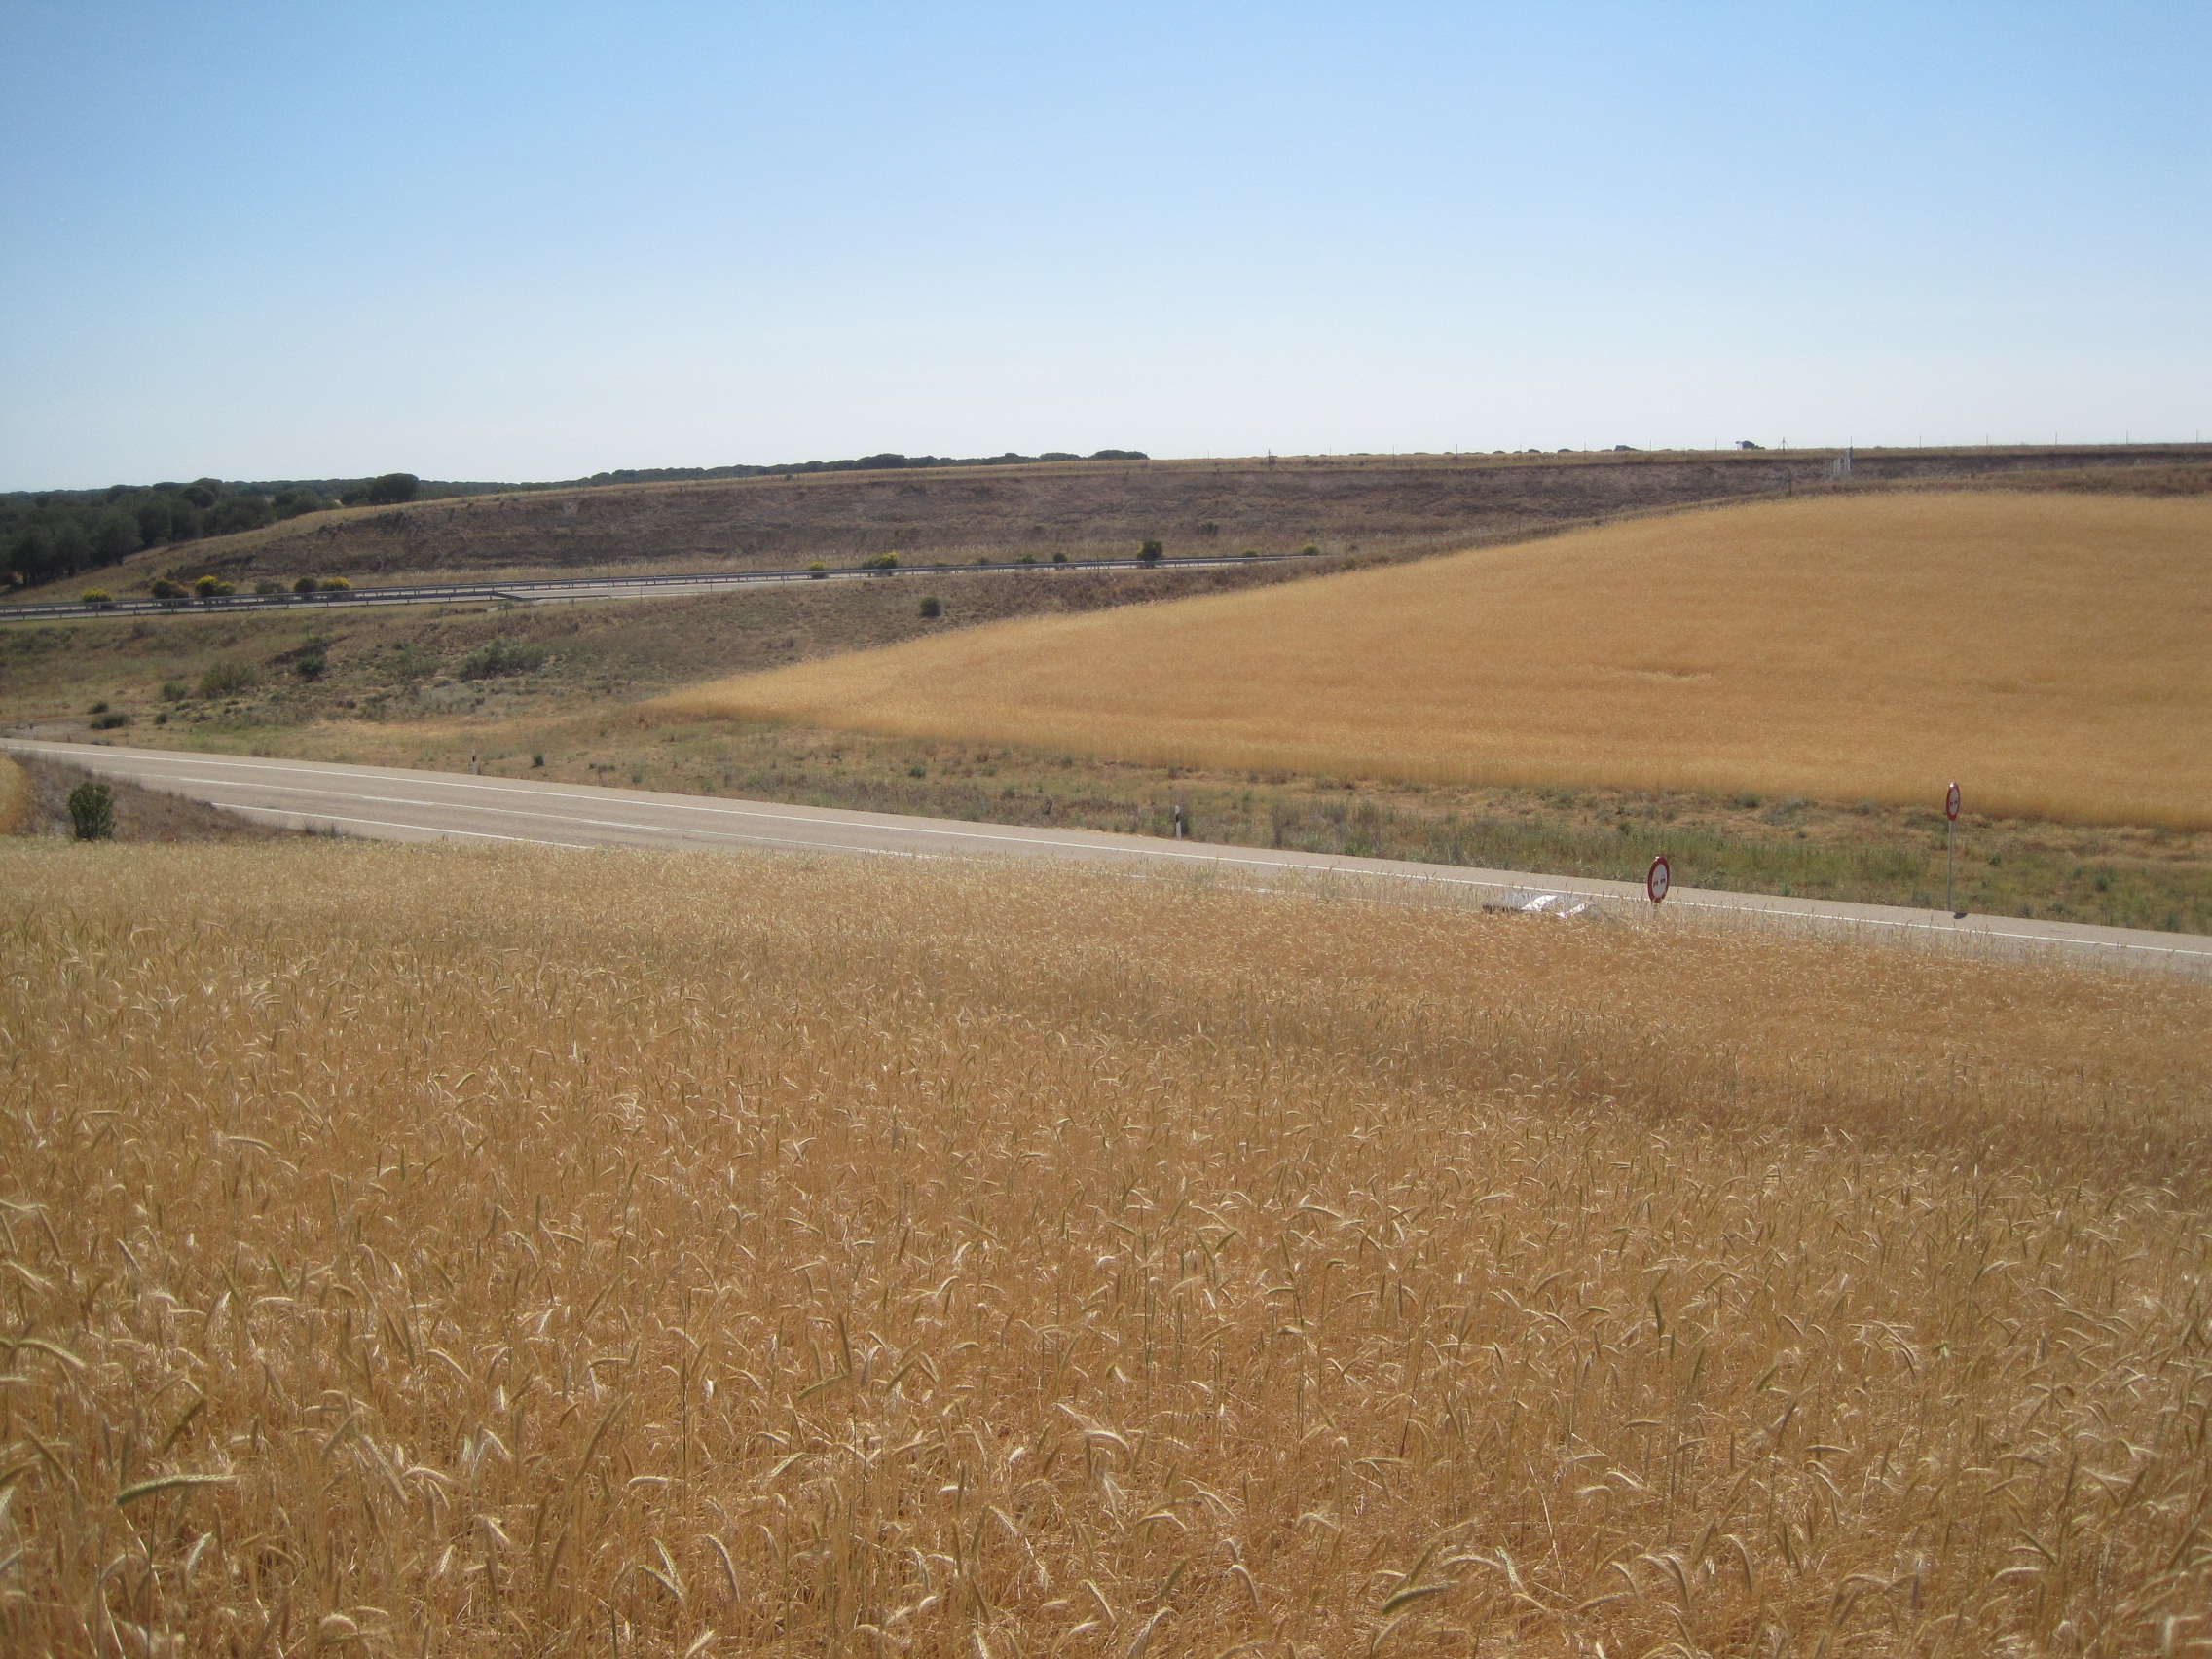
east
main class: Cropland
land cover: Rye
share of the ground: > 75 %
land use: Agriculture (excluding fallow land and kitchen gardens)
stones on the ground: 25 - 50 %
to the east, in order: Rye; Grassland without tree/shrub cover; Paved roads, cycling and walking lanes; Grassland without tree/shrub cover; Rye; Grassland without tree/shrub cover; Fences; Grassland without tree/shrub cover; Other structural elements; Paved roads, cycling and walking lanes; Shruby margins; Other structural elements; Shruby margins; Paved roads, cycling and walking lanes; Other structural elements; Grass margins; Grassland without tree/shrub cover; Fences; Tracks; Arable land (only in case pi)
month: June
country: ES
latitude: 41.4420
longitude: -5.0938
